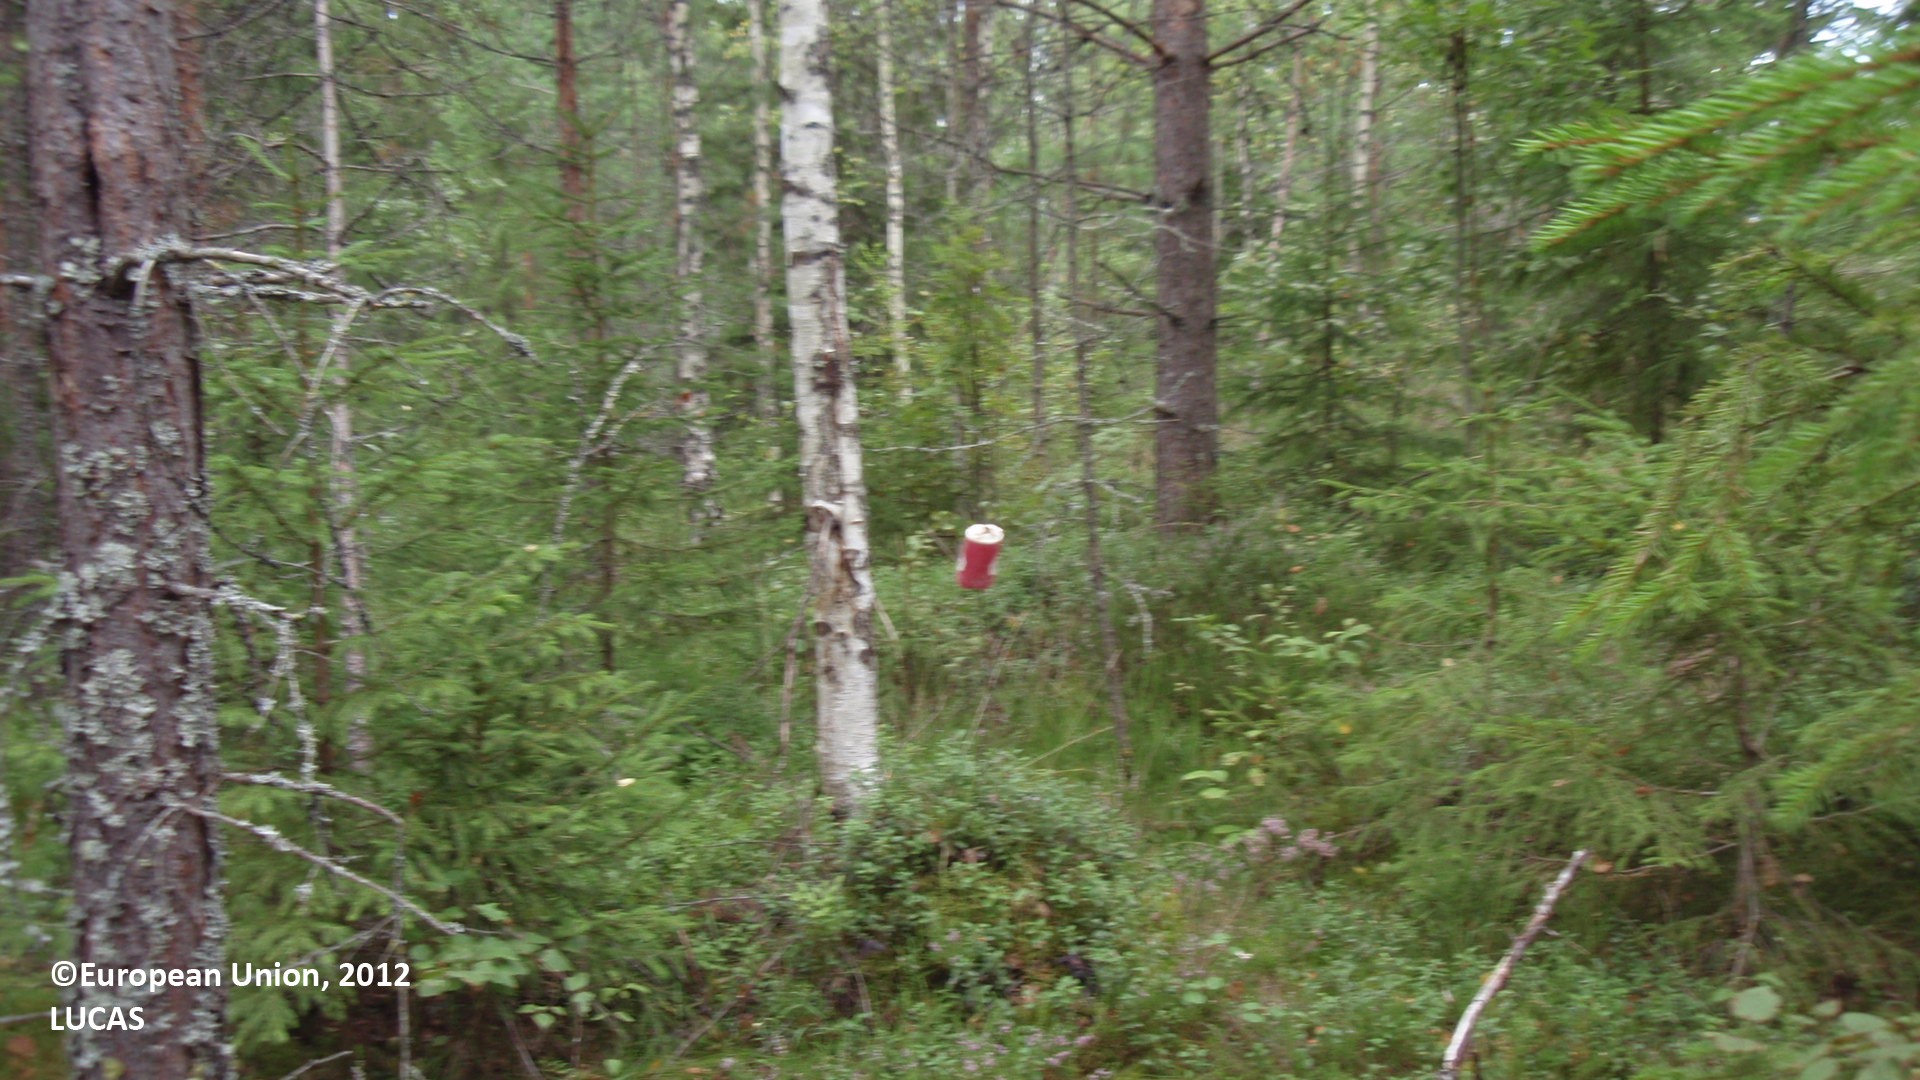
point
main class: Woodland
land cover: Other coniferous woodland
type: boreal forest
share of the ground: 50 - 75 %
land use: Forestry
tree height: > 5 m
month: August
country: FI
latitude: 61.1237
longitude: 27.6924
